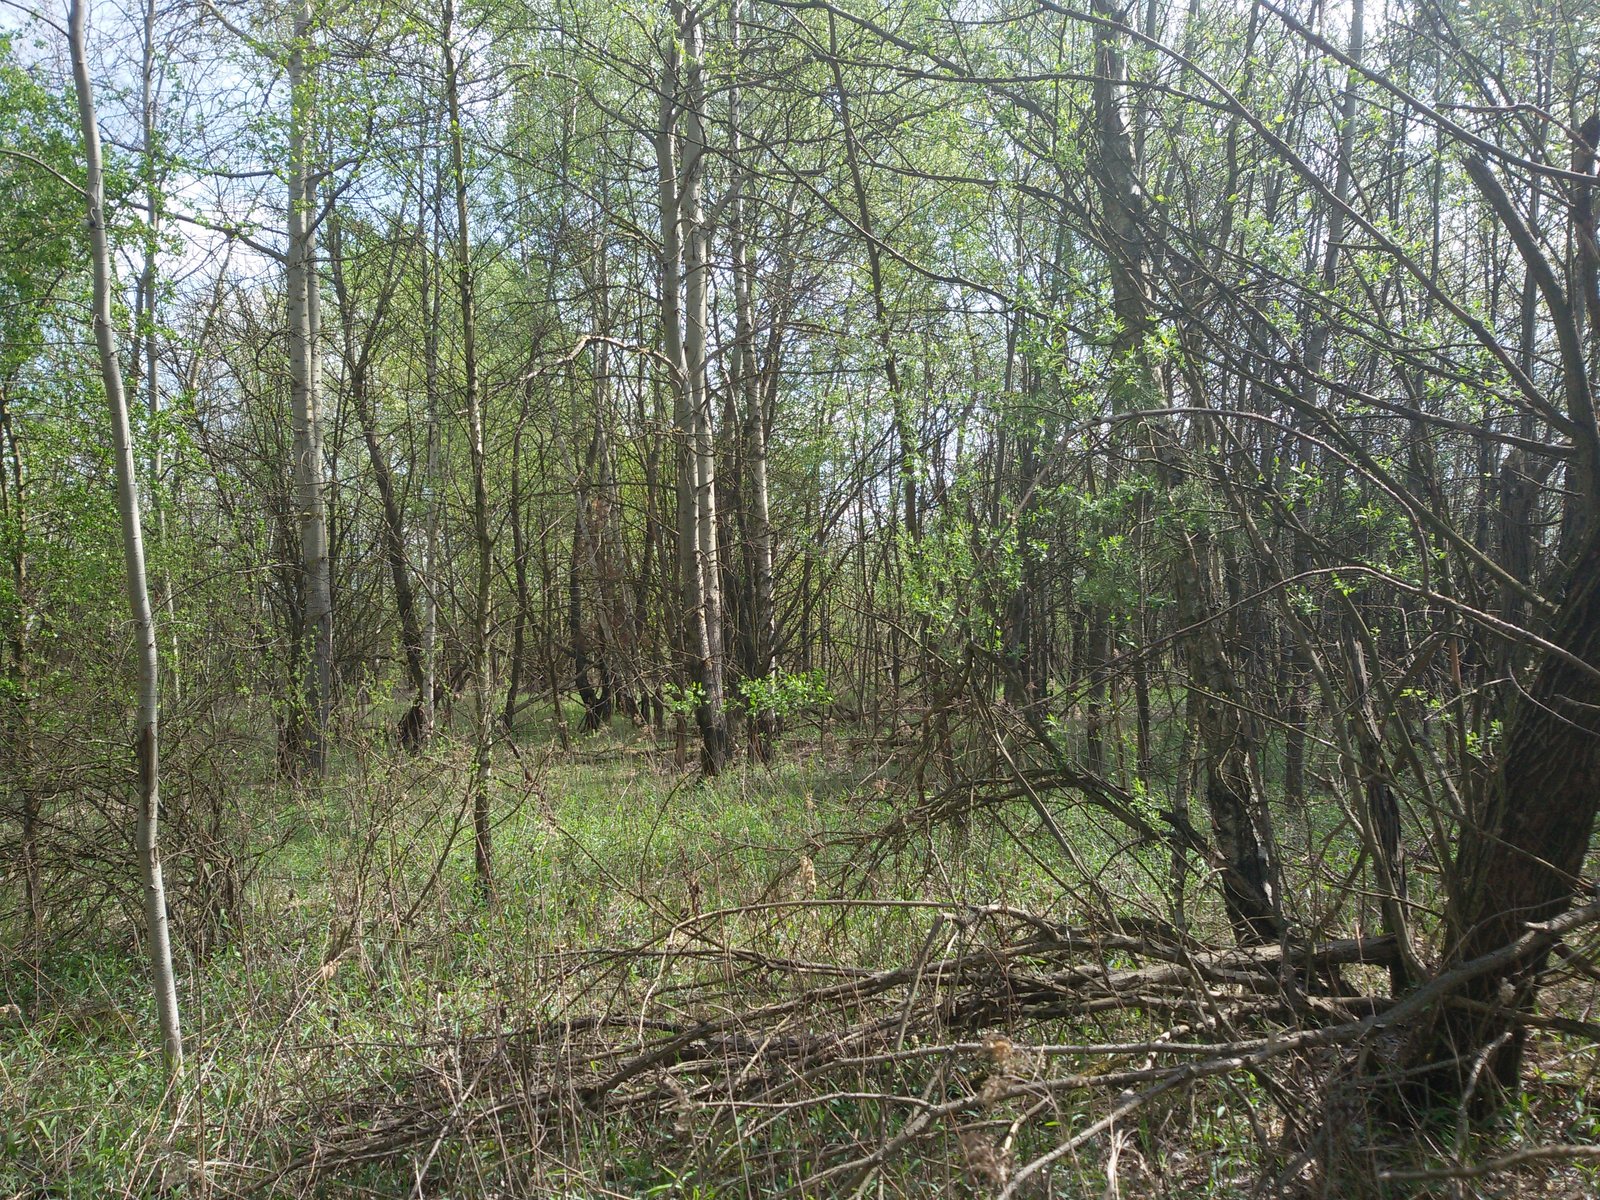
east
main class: Woodland
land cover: Broadleaved woodland
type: hemiboreal forest and nemoral coniferous forest and mixed broadleaved-coniferous forest
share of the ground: > 75 %
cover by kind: broadleaved forest trees 90 %, coniferous forest trees 10 %
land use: Forestry
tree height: > 5 m
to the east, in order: Broadleaved woodland; Spontaneously vegetated surfaces; Broadleaved woodland; Spontaneously vegetated surfaces
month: April
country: PL
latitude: 50.5283
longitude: 21.6629
